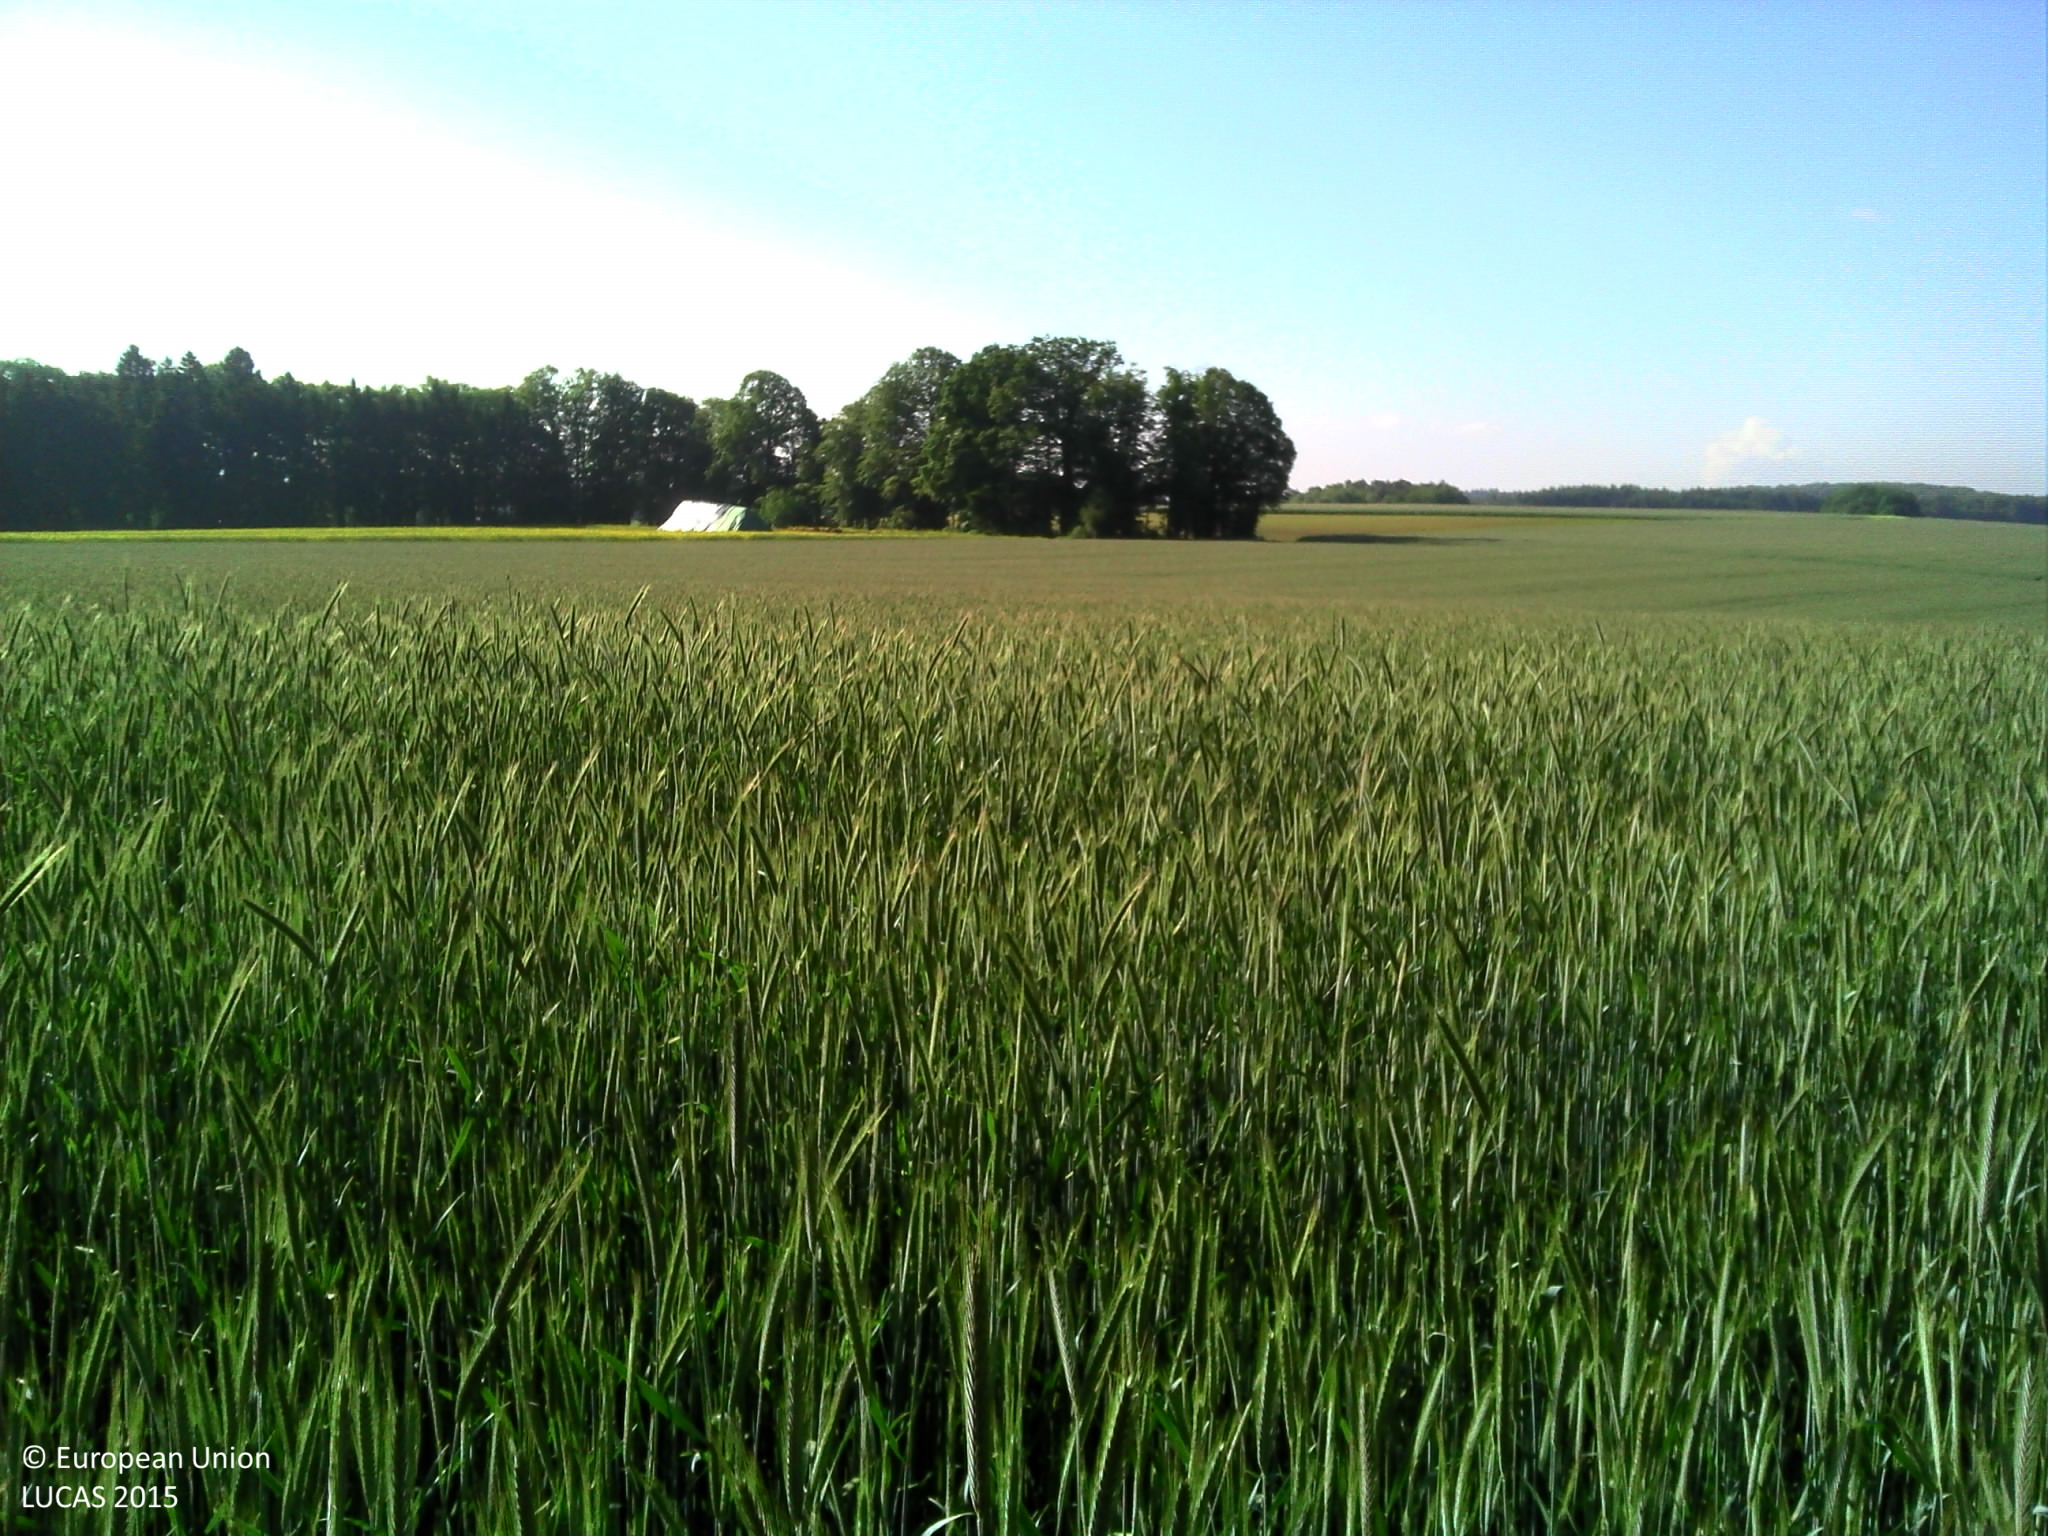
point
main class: Cropland
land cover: Triticale
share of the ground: > 75 %
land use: Agriculture (excluding fallow land and kitchen gardens)
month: May
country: LU
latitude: 49.7036
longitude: 6.1031
